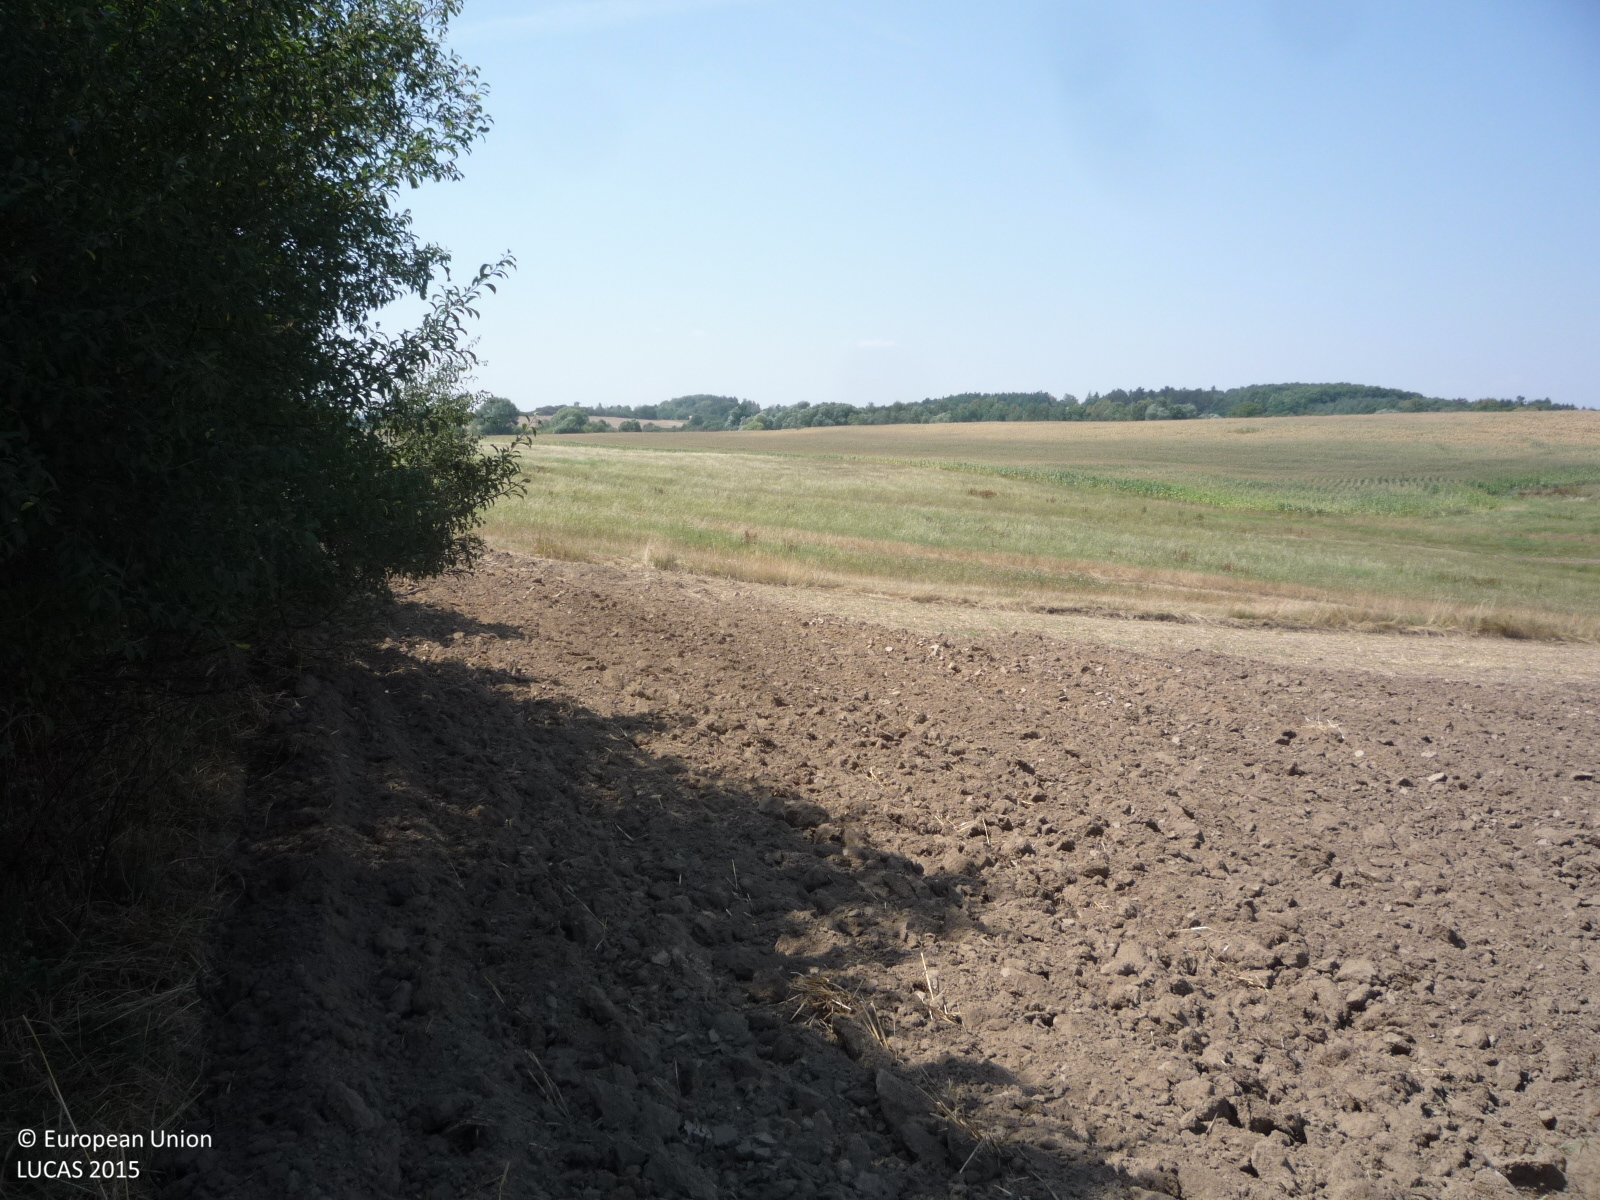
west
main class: Cropland
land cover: Barley
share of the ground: < 10 %
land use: Agriculture (excluding fallow land and kitchen gardens)
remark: Harvested field
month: August
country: CZ
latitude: 49.8368
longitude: 14.6597
